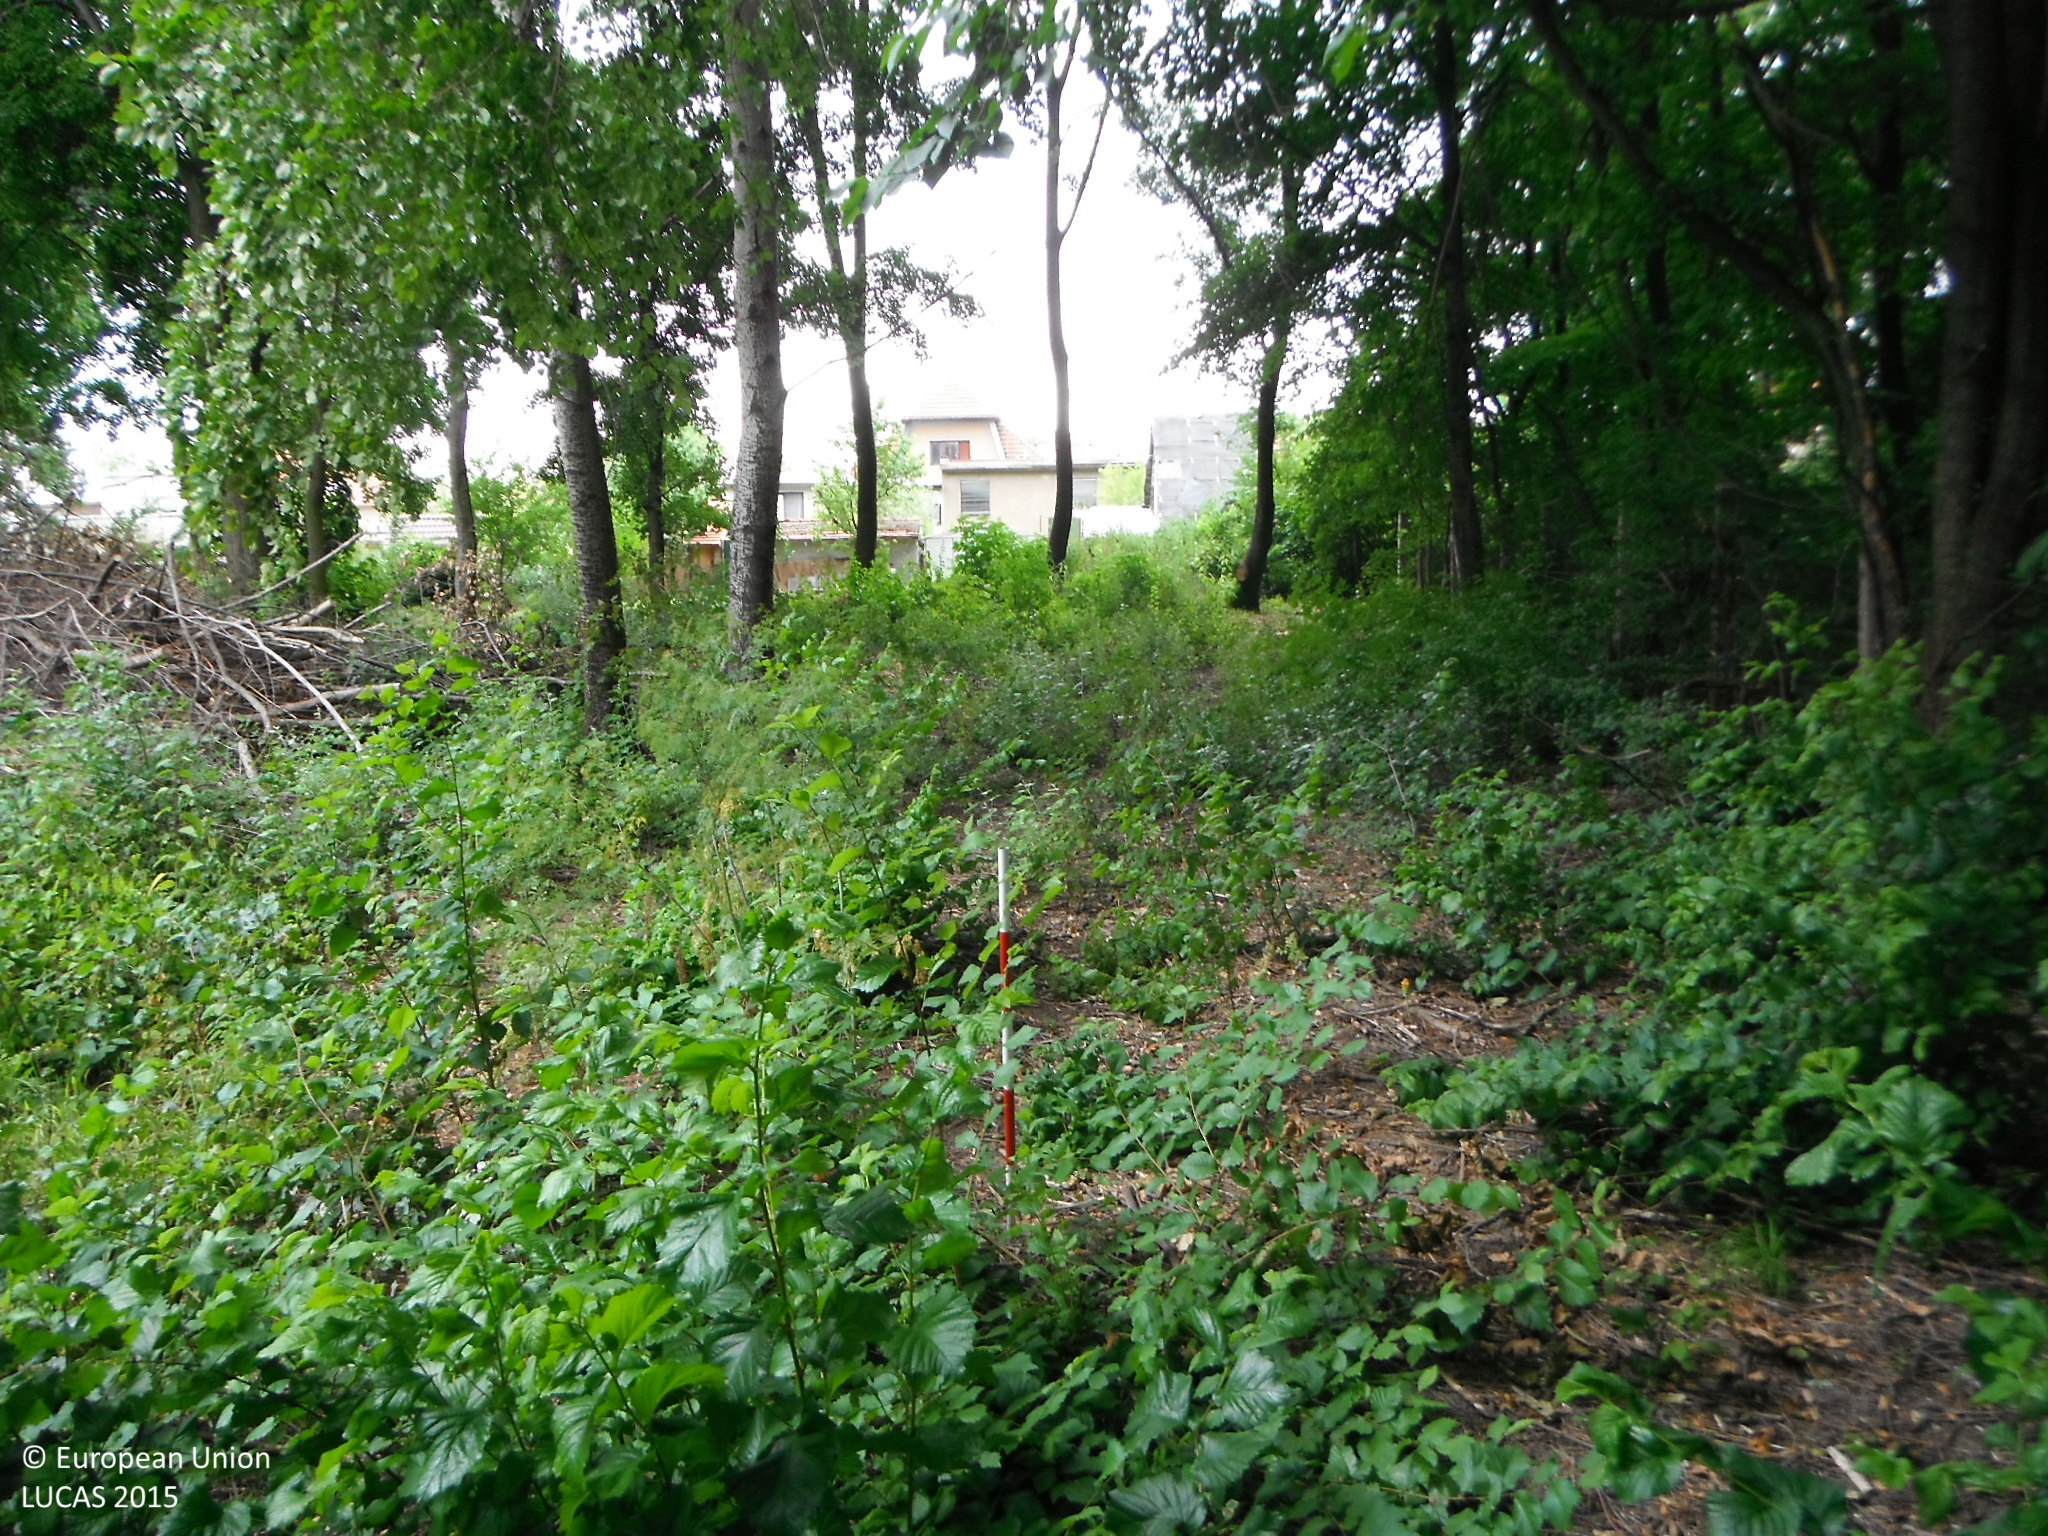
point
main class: Woodland
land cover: Broadleaved woodland
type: mesophytic deciduous forest
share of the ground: 50 - 75 %
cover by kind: broadleaved forest trees 50 %, herbaceous plants 40 %, shrubs 10 %
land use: Amenities, museums, leisure
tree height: > 5 m
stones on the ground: < 10 %
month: July
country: SK
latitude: 48.6311
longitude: 18.3336
